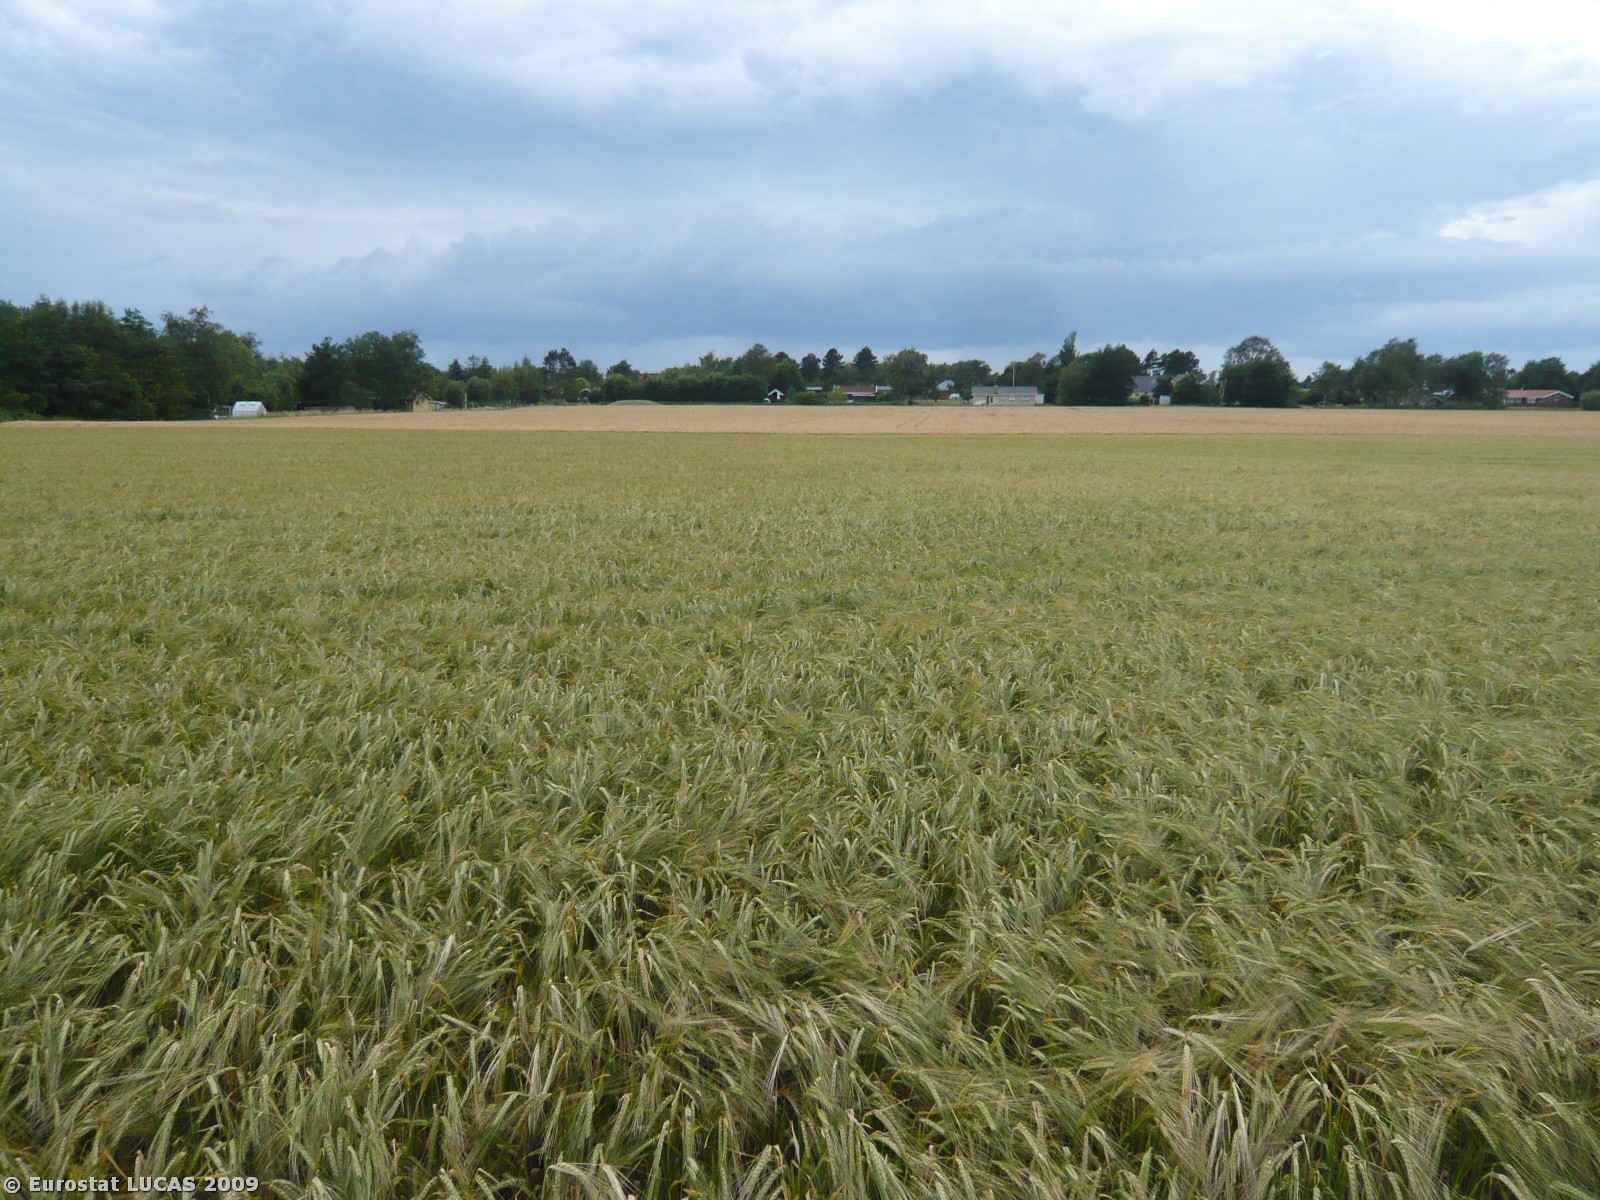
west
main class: Cropland
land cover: Barley
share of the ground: > 75 %
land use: Agriculture (excluding fallow land and kitchen gardens)
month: July
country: DK
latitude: 55.4449
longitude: 11.2162
